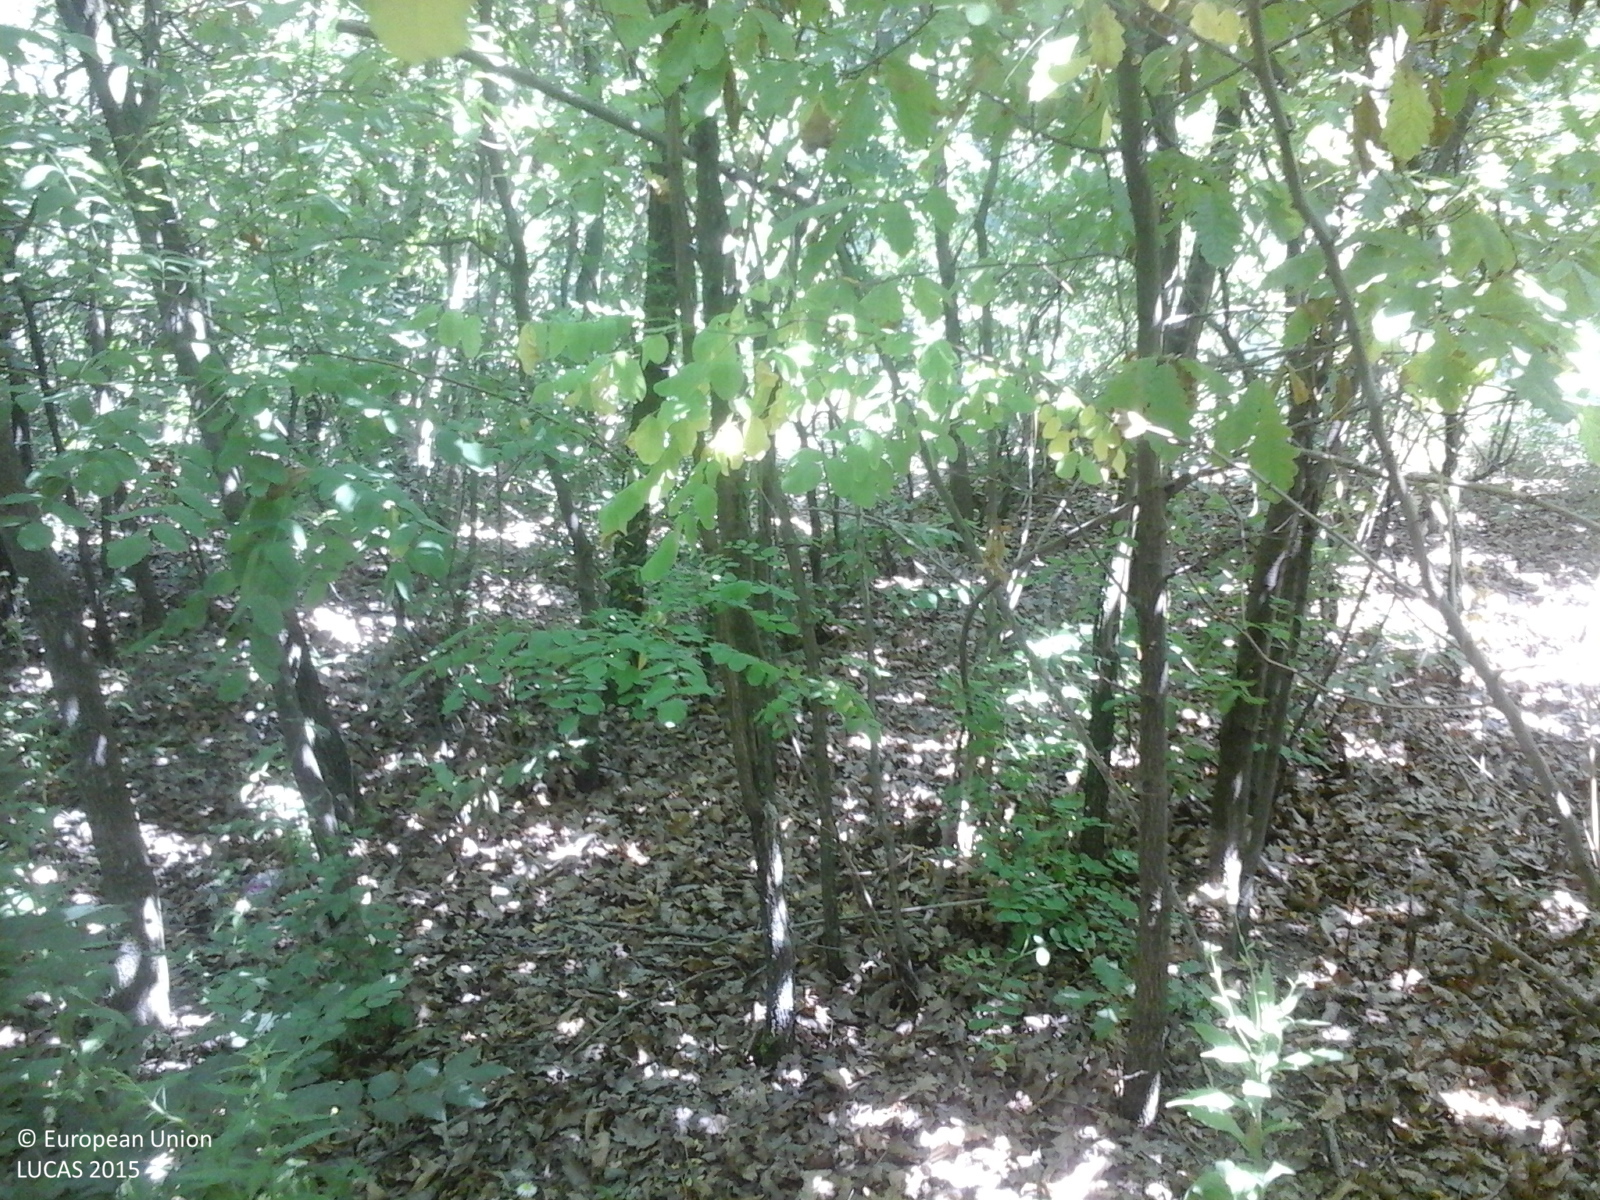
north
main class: Woodland
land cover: Broadleaved woodland
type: mesophytic deciduous forest
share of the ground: > 75 %
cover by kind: broadleaved forest trees 90 %, shrubs 5 %, herbaceous plants 5 %
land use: Forestry
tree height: > 5 m
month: July
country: RO
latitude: 44.2683
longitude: 24.5645
